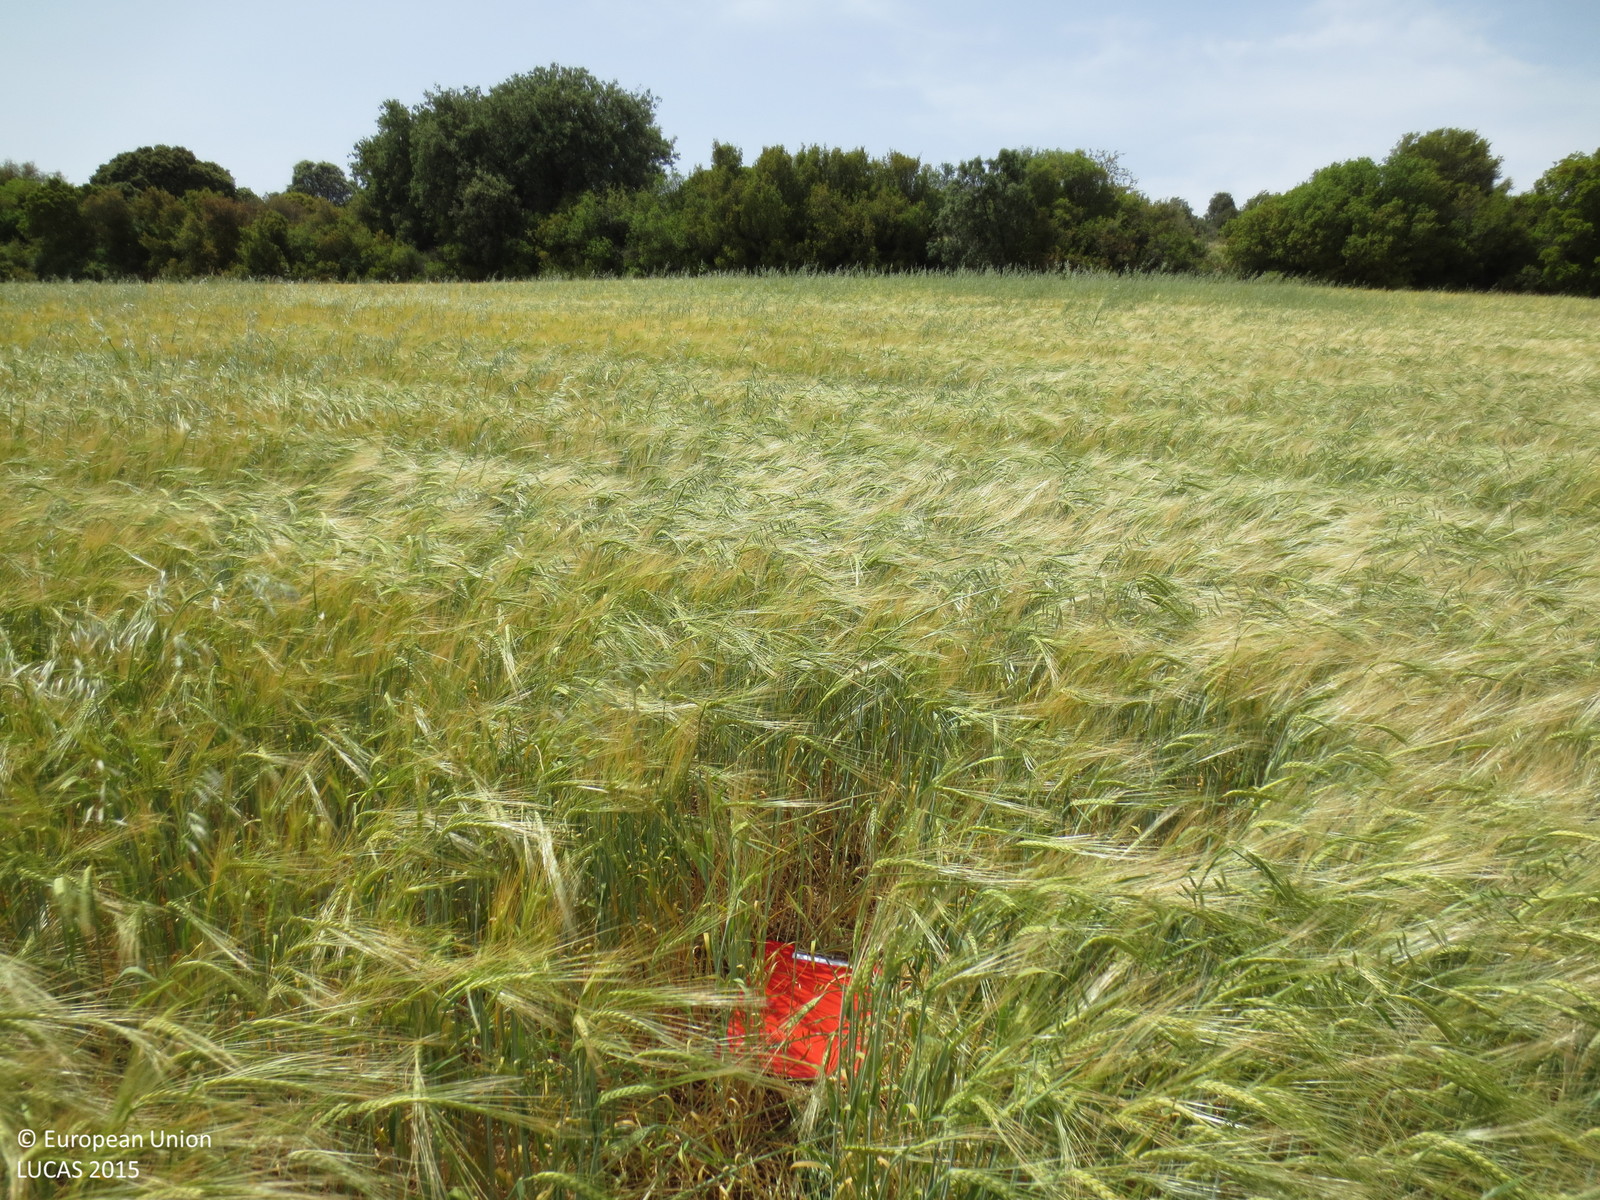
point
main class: Cropland
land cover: Barley
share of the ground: > 75 %
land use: Agriculture (excluding fallow land and kitchen gardens)
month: May
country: ES
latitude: 40.4236
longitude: -2.5768
